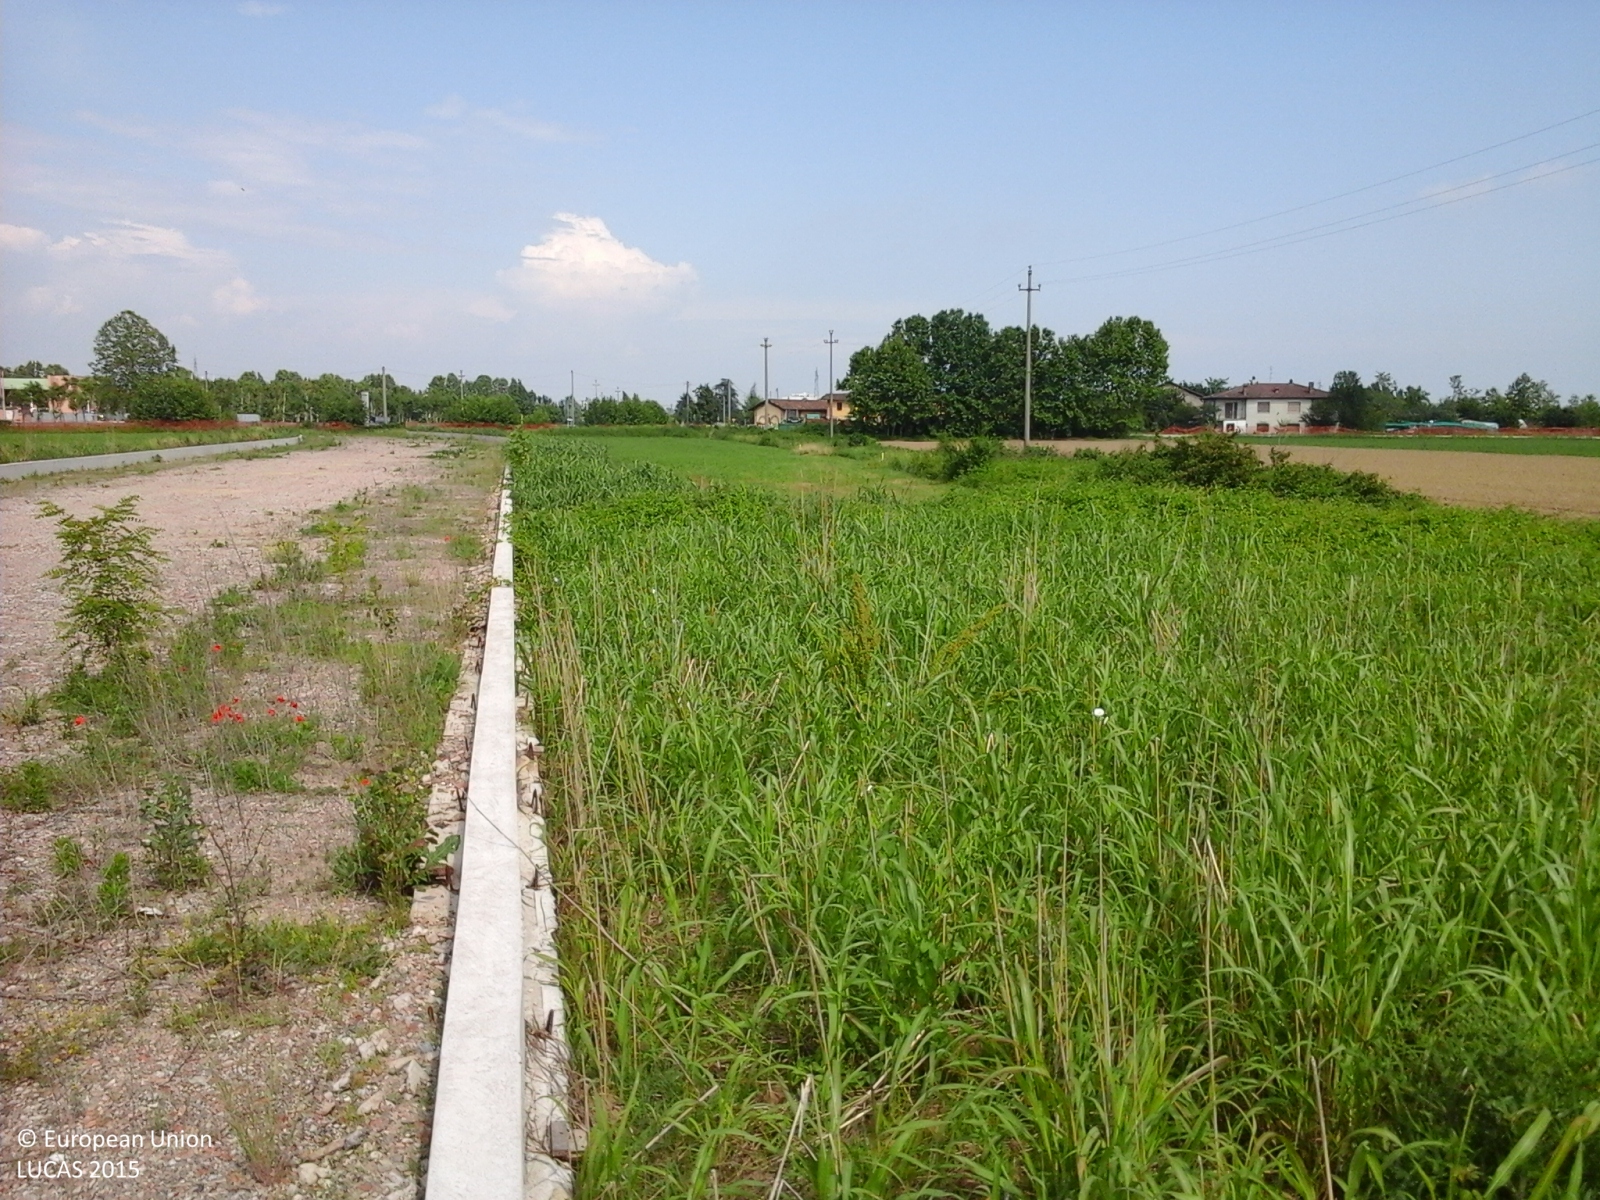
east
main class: Grassland
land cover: Spontaneously vegetated surfaces
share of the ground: > 75 %
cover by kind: herbaceous plants 100 %
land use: Fallow land
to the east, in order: Spontaneously vegetated surfaces; Abandoned hedges; Ditches and canals; Abandoned hedges; Maize; Abandoned hedges; Ditches and canals; Abandoned hedges; Grassland without tree/shrub cover; Paved roads, cycling and walking lanes; Grassland without tree/shrub cover; Tracks
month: May
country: IT
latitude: 45.4858
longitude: 9.6551
